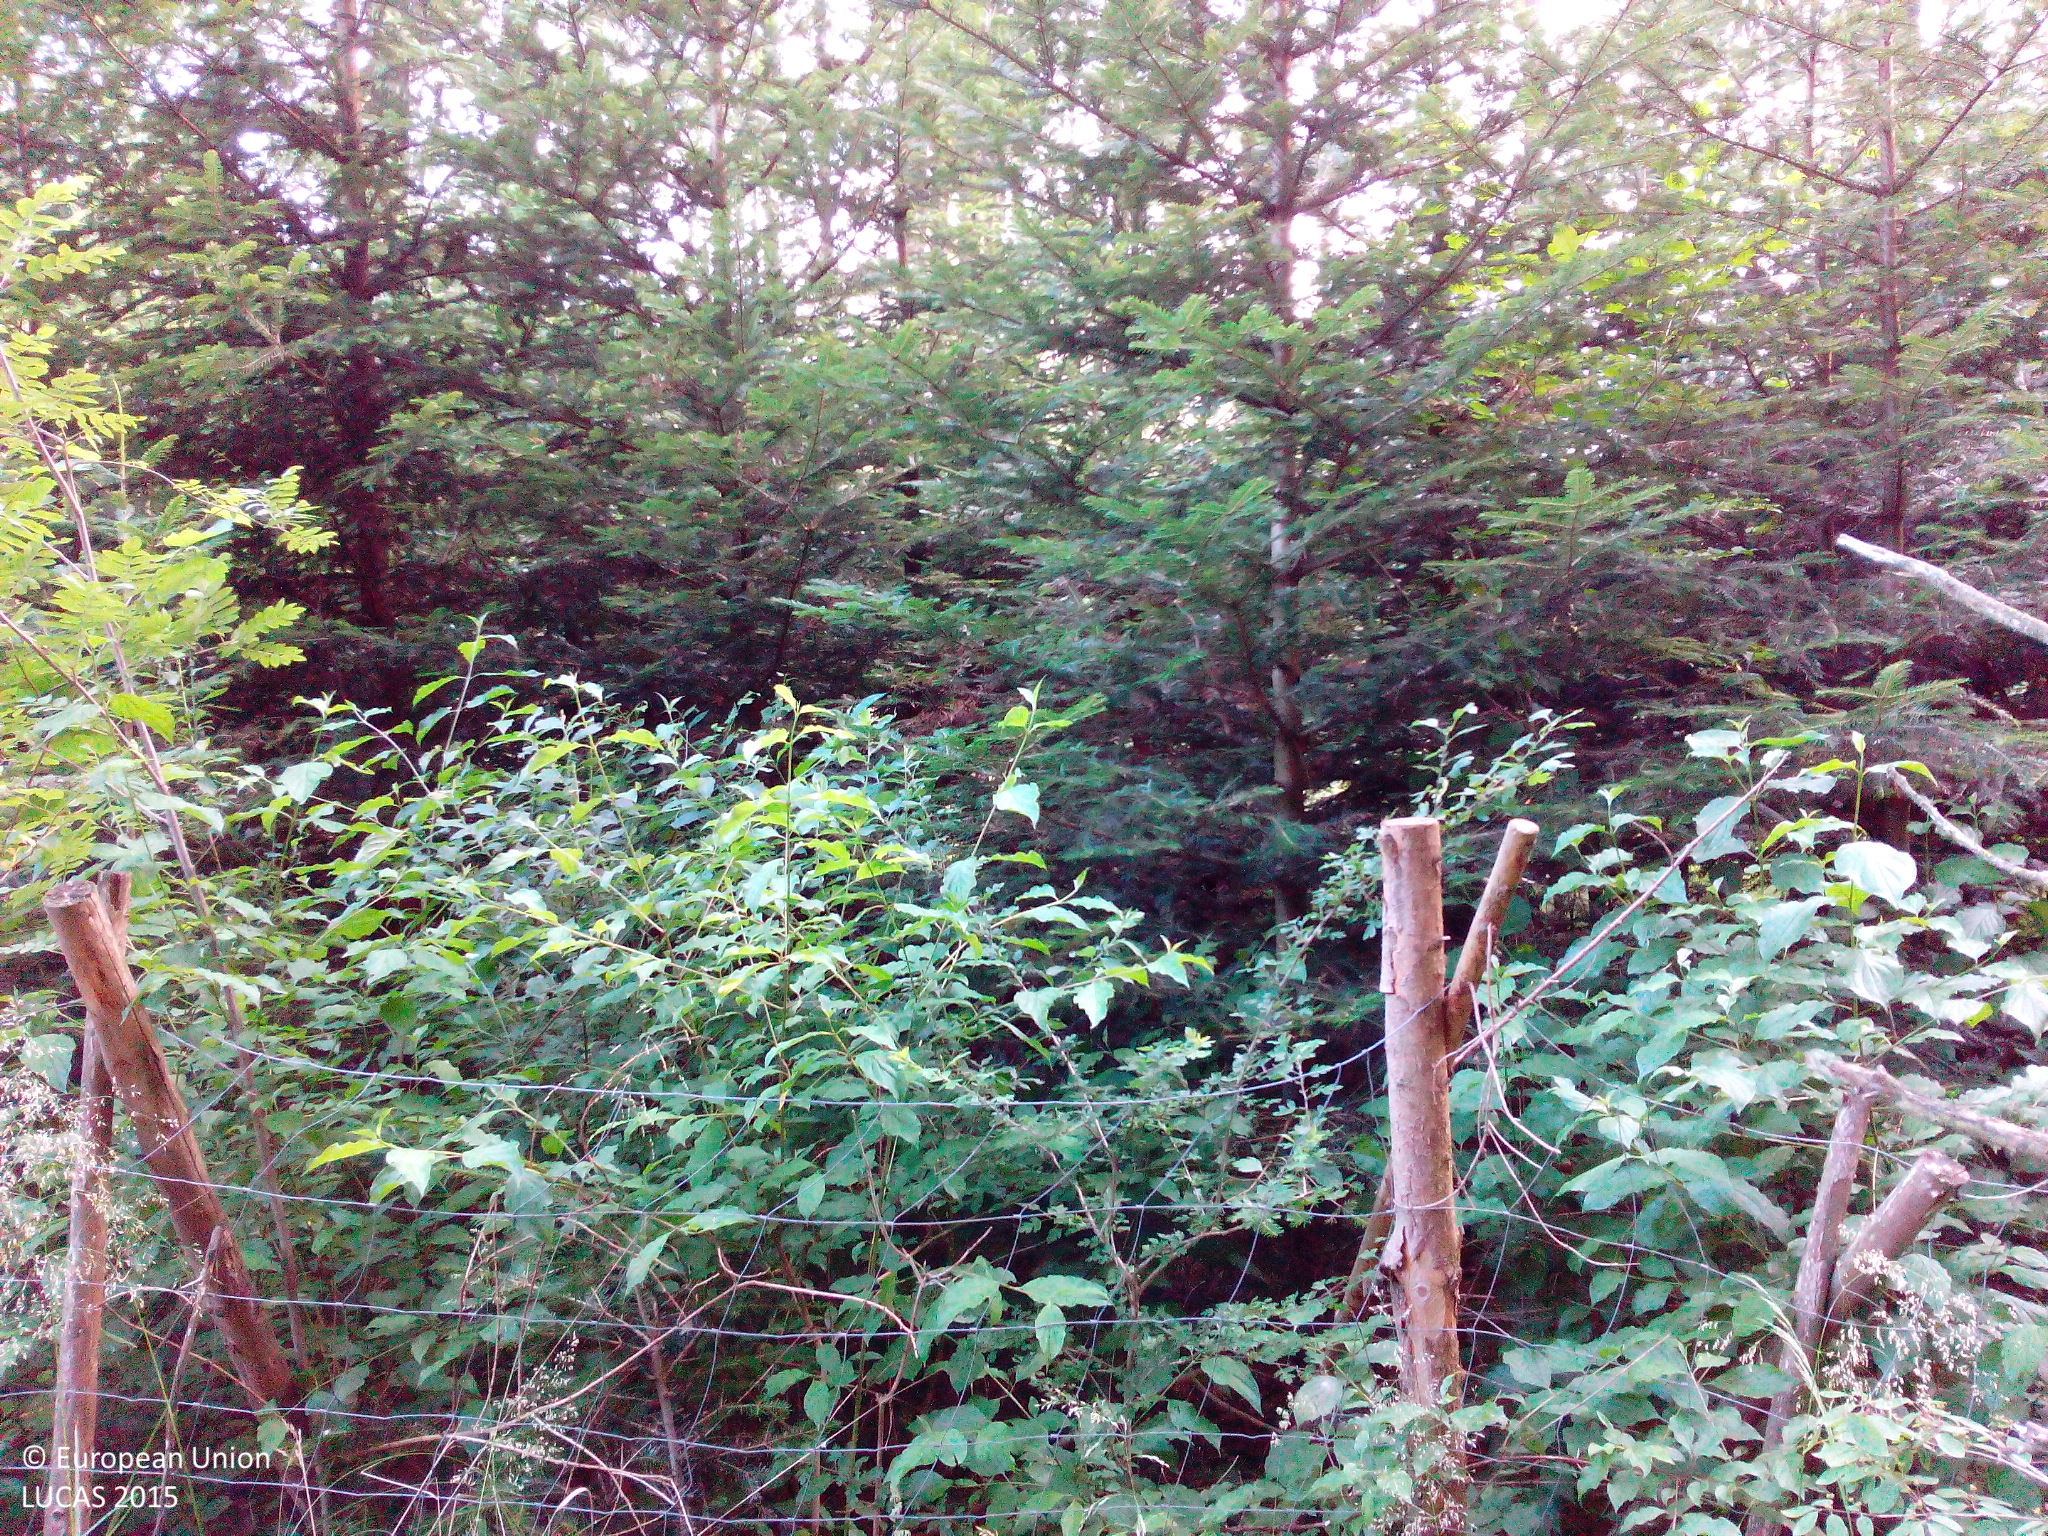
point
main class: Woodland
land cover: Spruce dominated coniferous woodland
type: hemiboreal forest and nemoral coniferous forest and mixed broadleaved-coniferous forest
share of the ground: > 75 %
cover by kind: coniferous forest trees 85 %, shrubs 15 %
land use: Forestry
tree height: > 5 m
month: July
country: DE
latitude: 48.9037
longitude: 10.8864
